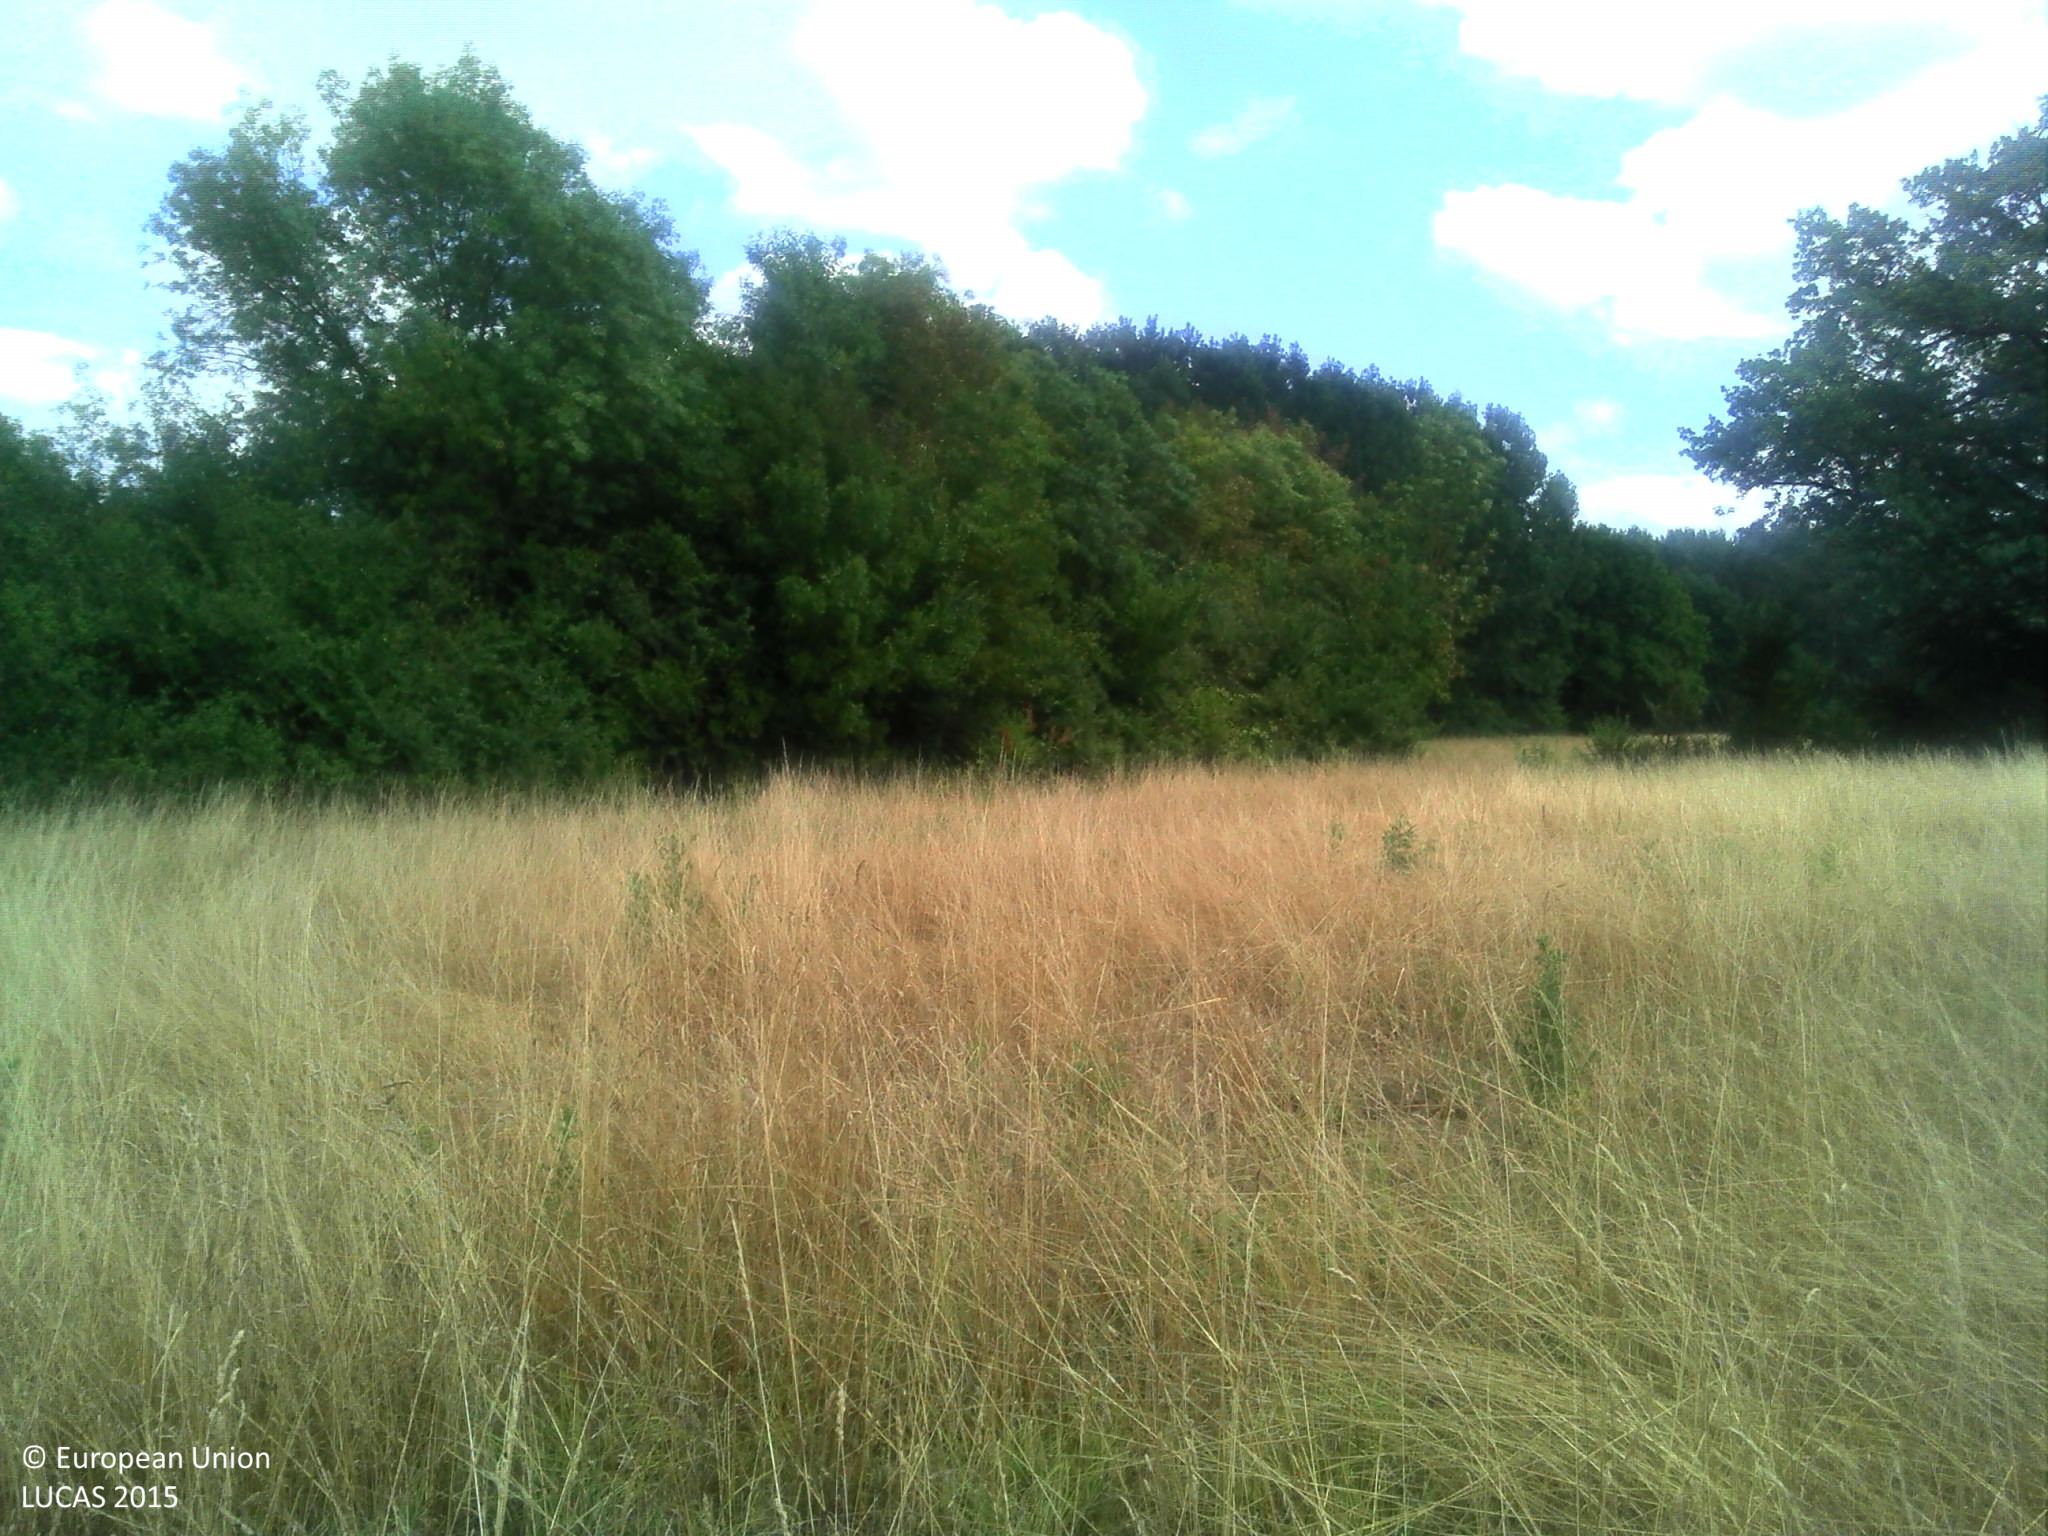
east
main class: Grassland
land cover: Grassland without tree/shrub cover
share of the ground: > 75 %
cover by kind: herbaceous plants 95 %, shrubs 5 %
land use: Agriculture (excluding fallow land and kitchen gardens)
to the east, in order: Grassland without tree/shrub cover; Abandoned hedges; Ditches and canals; Broadleaved woodland; Grassland without tree/shrub cover; Broadleaved woodland; Grassland without tree/shrub cover
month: July
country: FR
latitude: 43.8911
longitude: 0.6481
